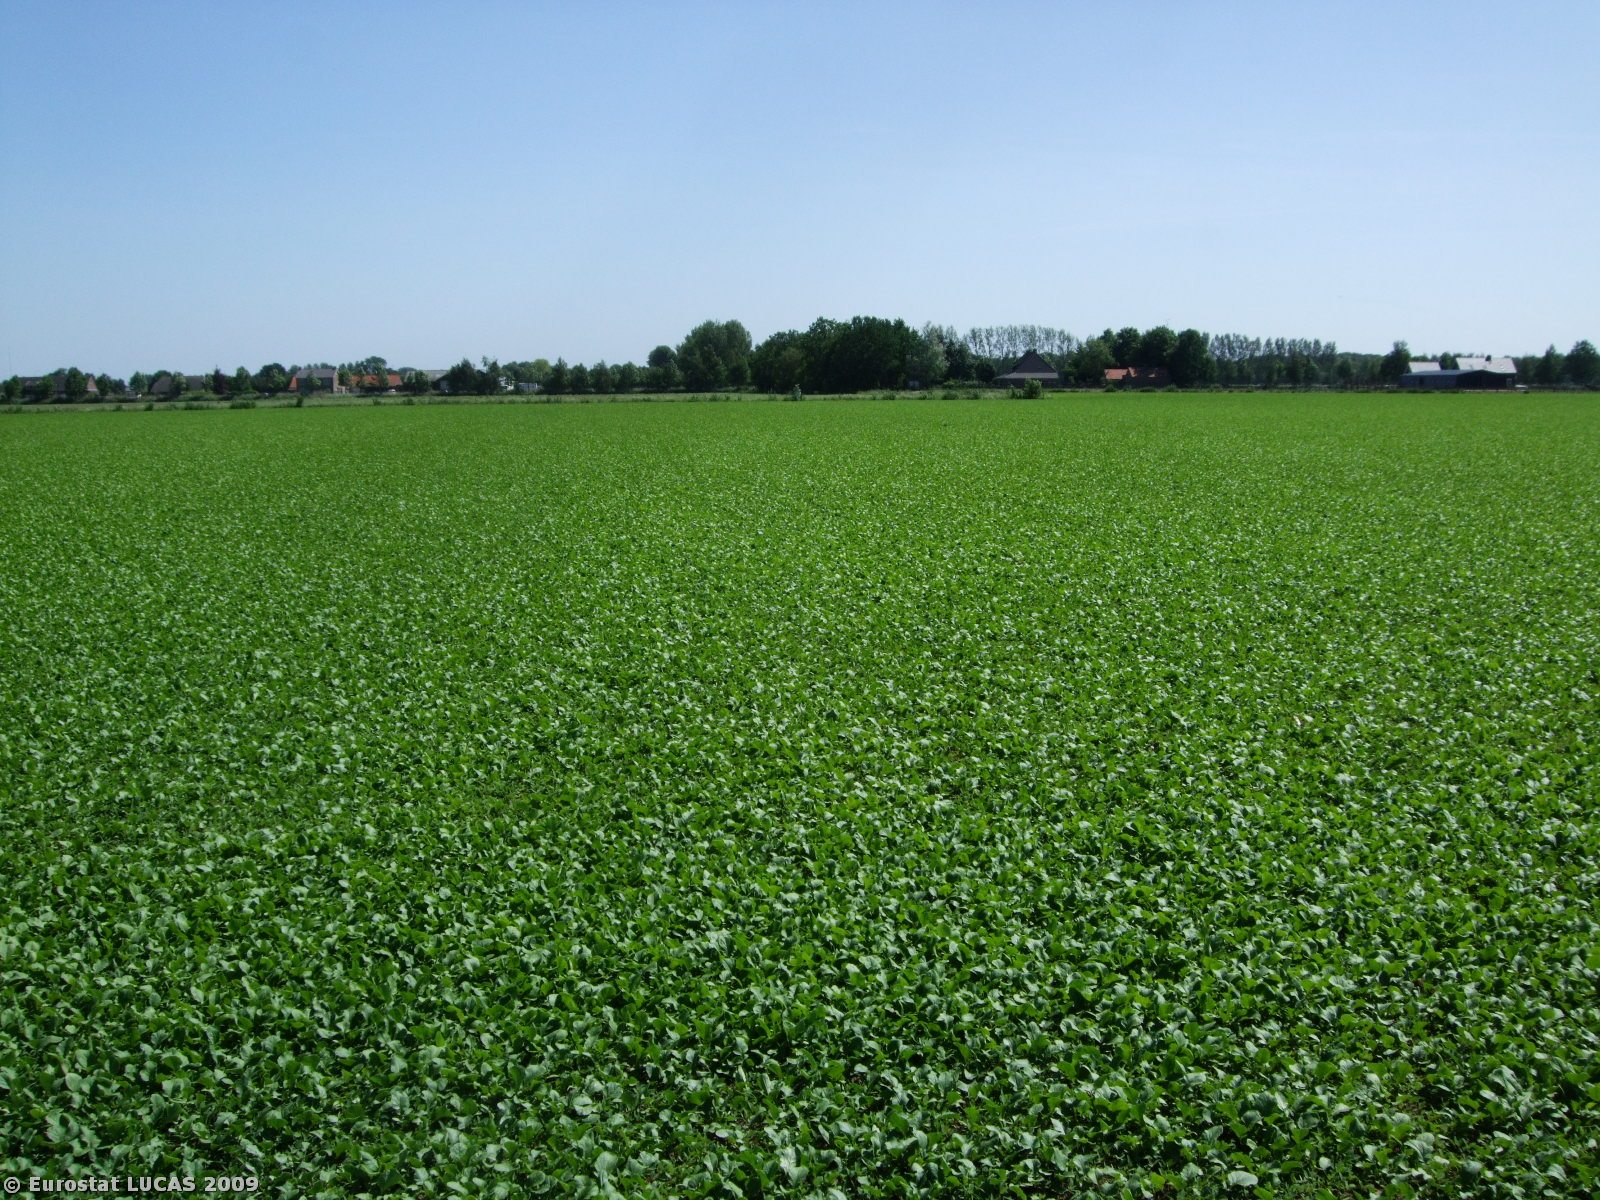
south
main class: Cropland
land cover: Other root crops
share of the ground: > 75 %
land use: Agriculture (excluding fallow land and kitchen gardens)
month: June
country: NL
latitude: 51.5882
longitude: 5.4516
